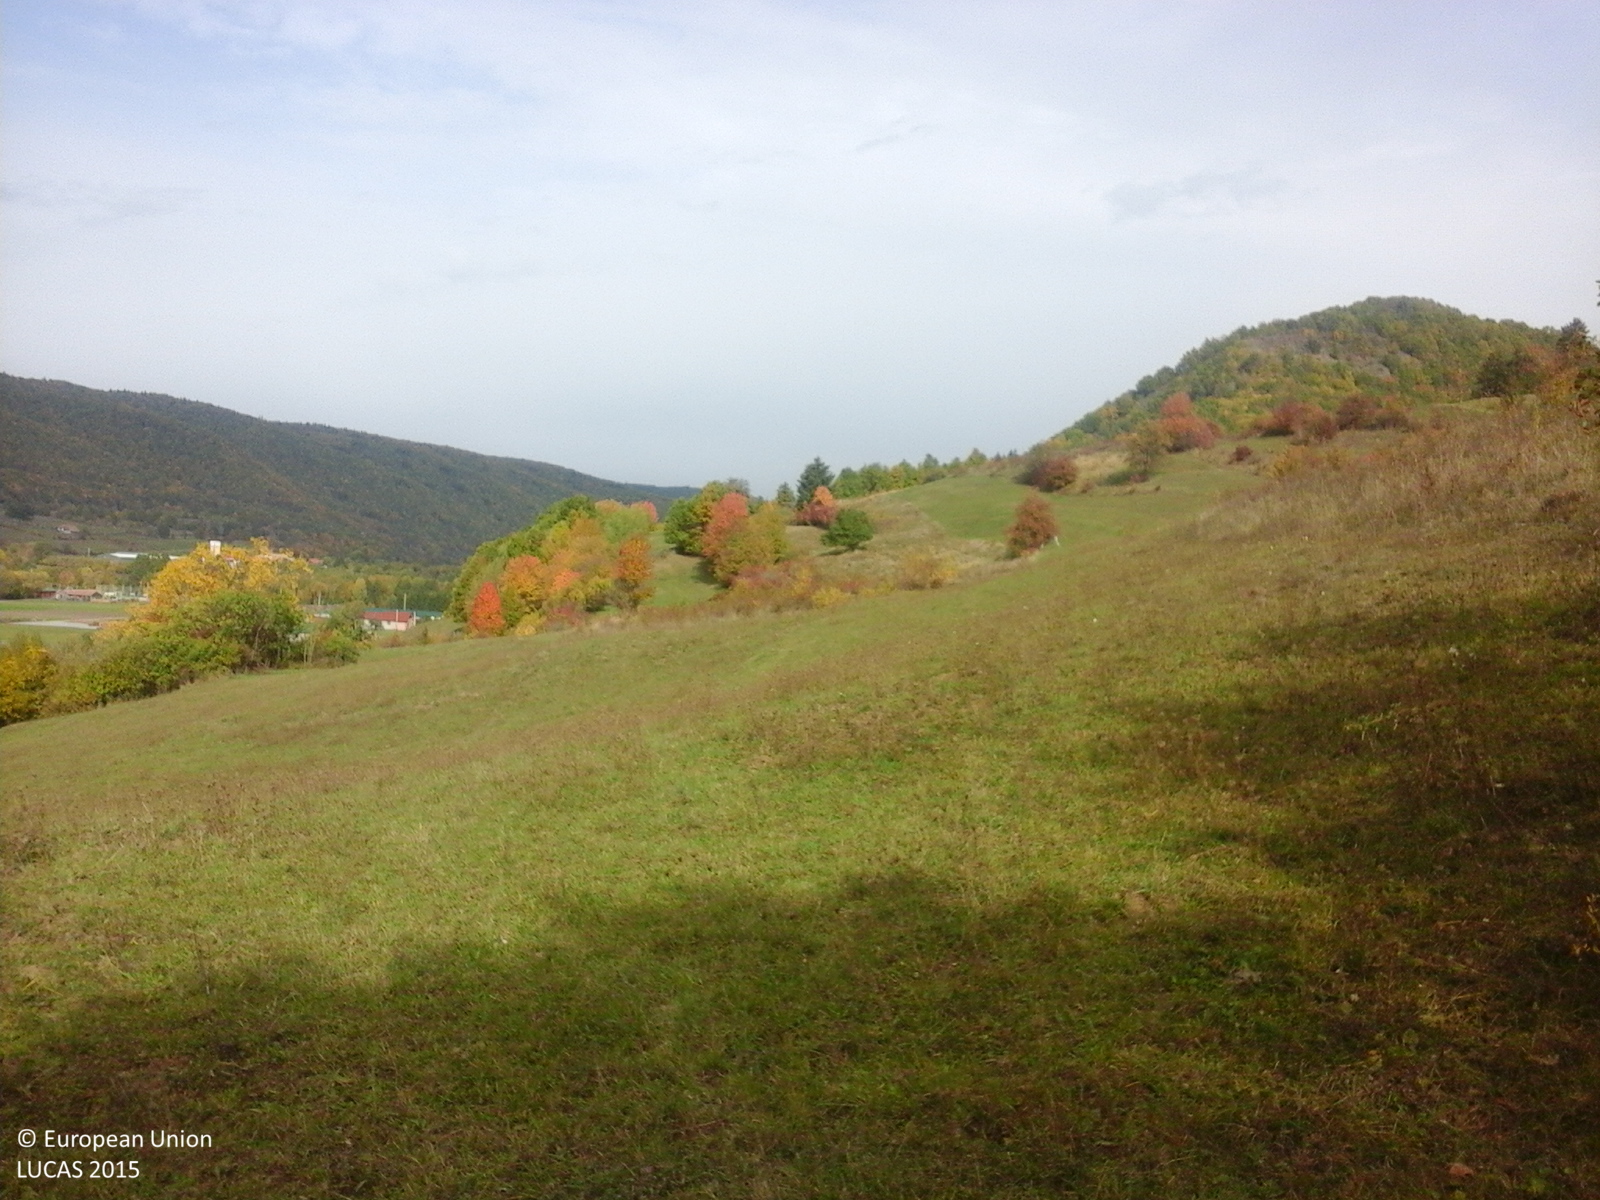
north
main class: Grassland
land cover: Grassland without tree/shrub cover
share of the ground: > 75 %
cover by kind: herbaceous plants 100 %
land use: Agriculture (excluding fallow land and kitchen gardens)
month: October
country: RO
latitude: 46.4194
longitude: 25.3937
